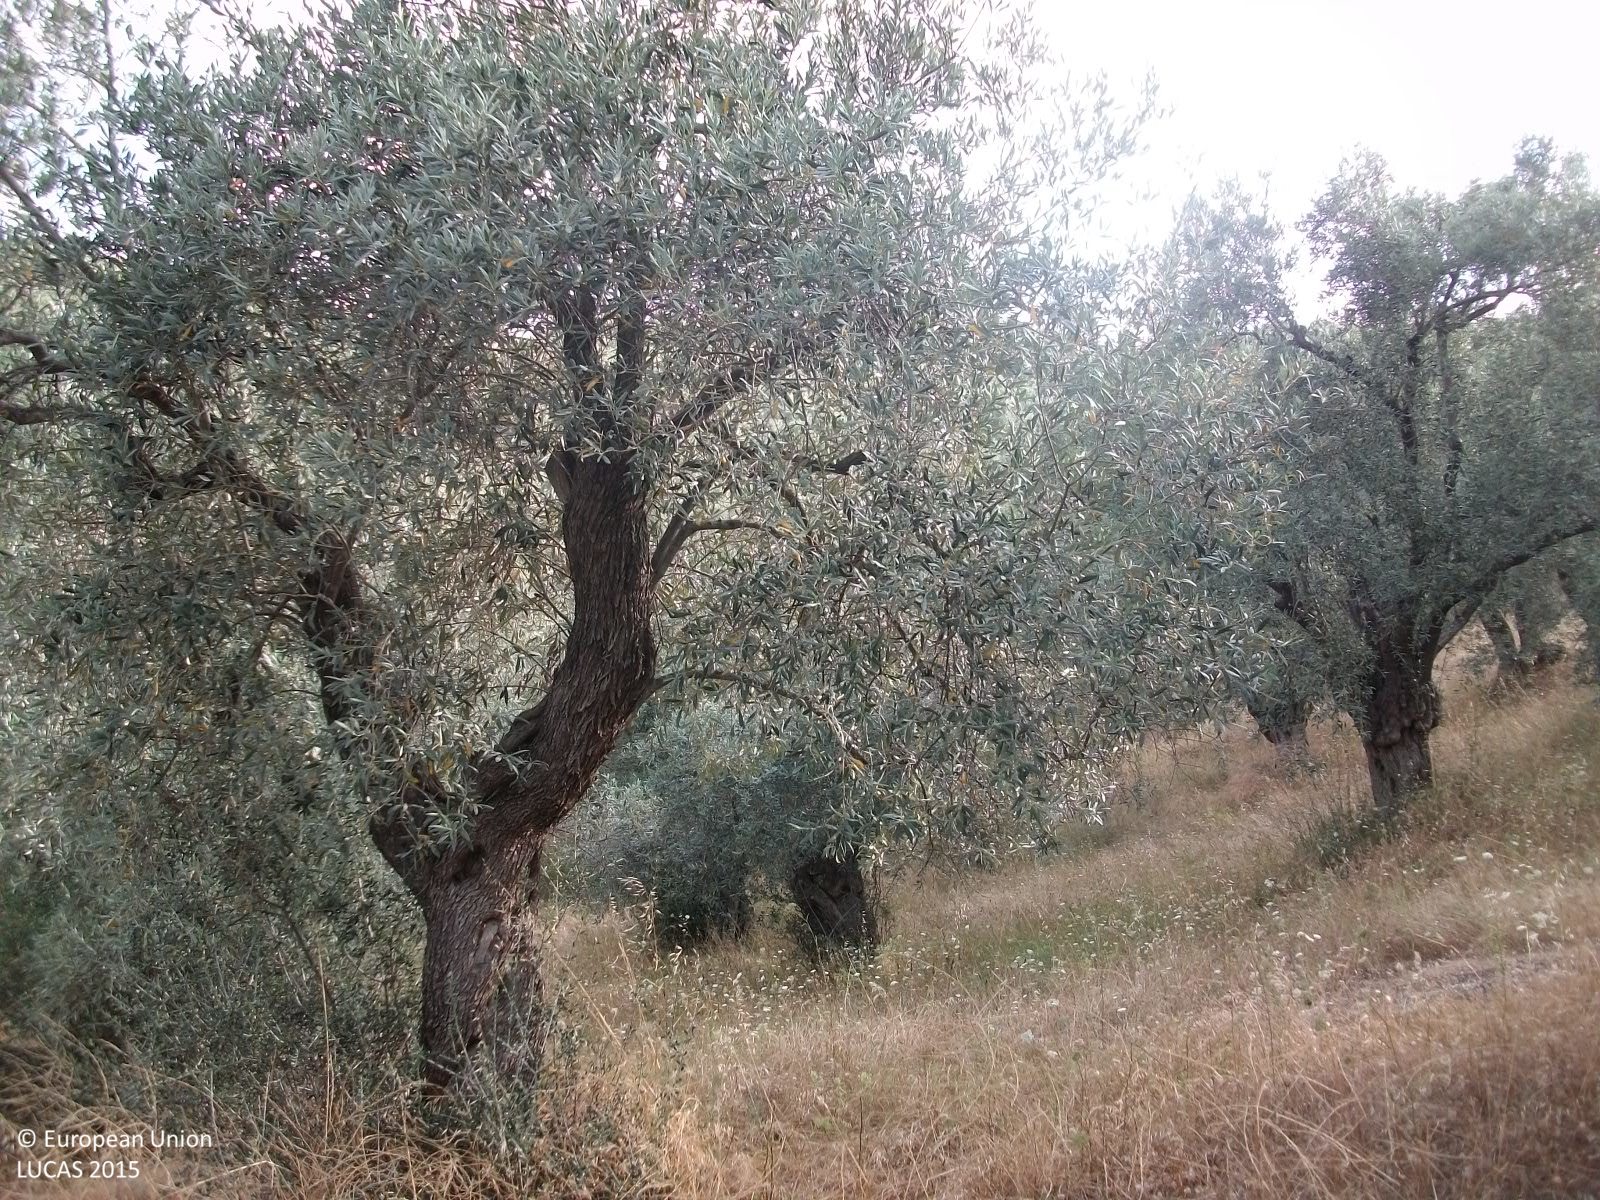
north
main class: Cropland
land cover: Olive groves
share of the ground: > 75 %
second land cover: Spontaneously vegetated surfaces
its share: > 75 %
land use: Agriculture (excluding fallow land and kitchen gardens)
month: June
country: GR
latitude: 39.3072
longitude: 23.1321
